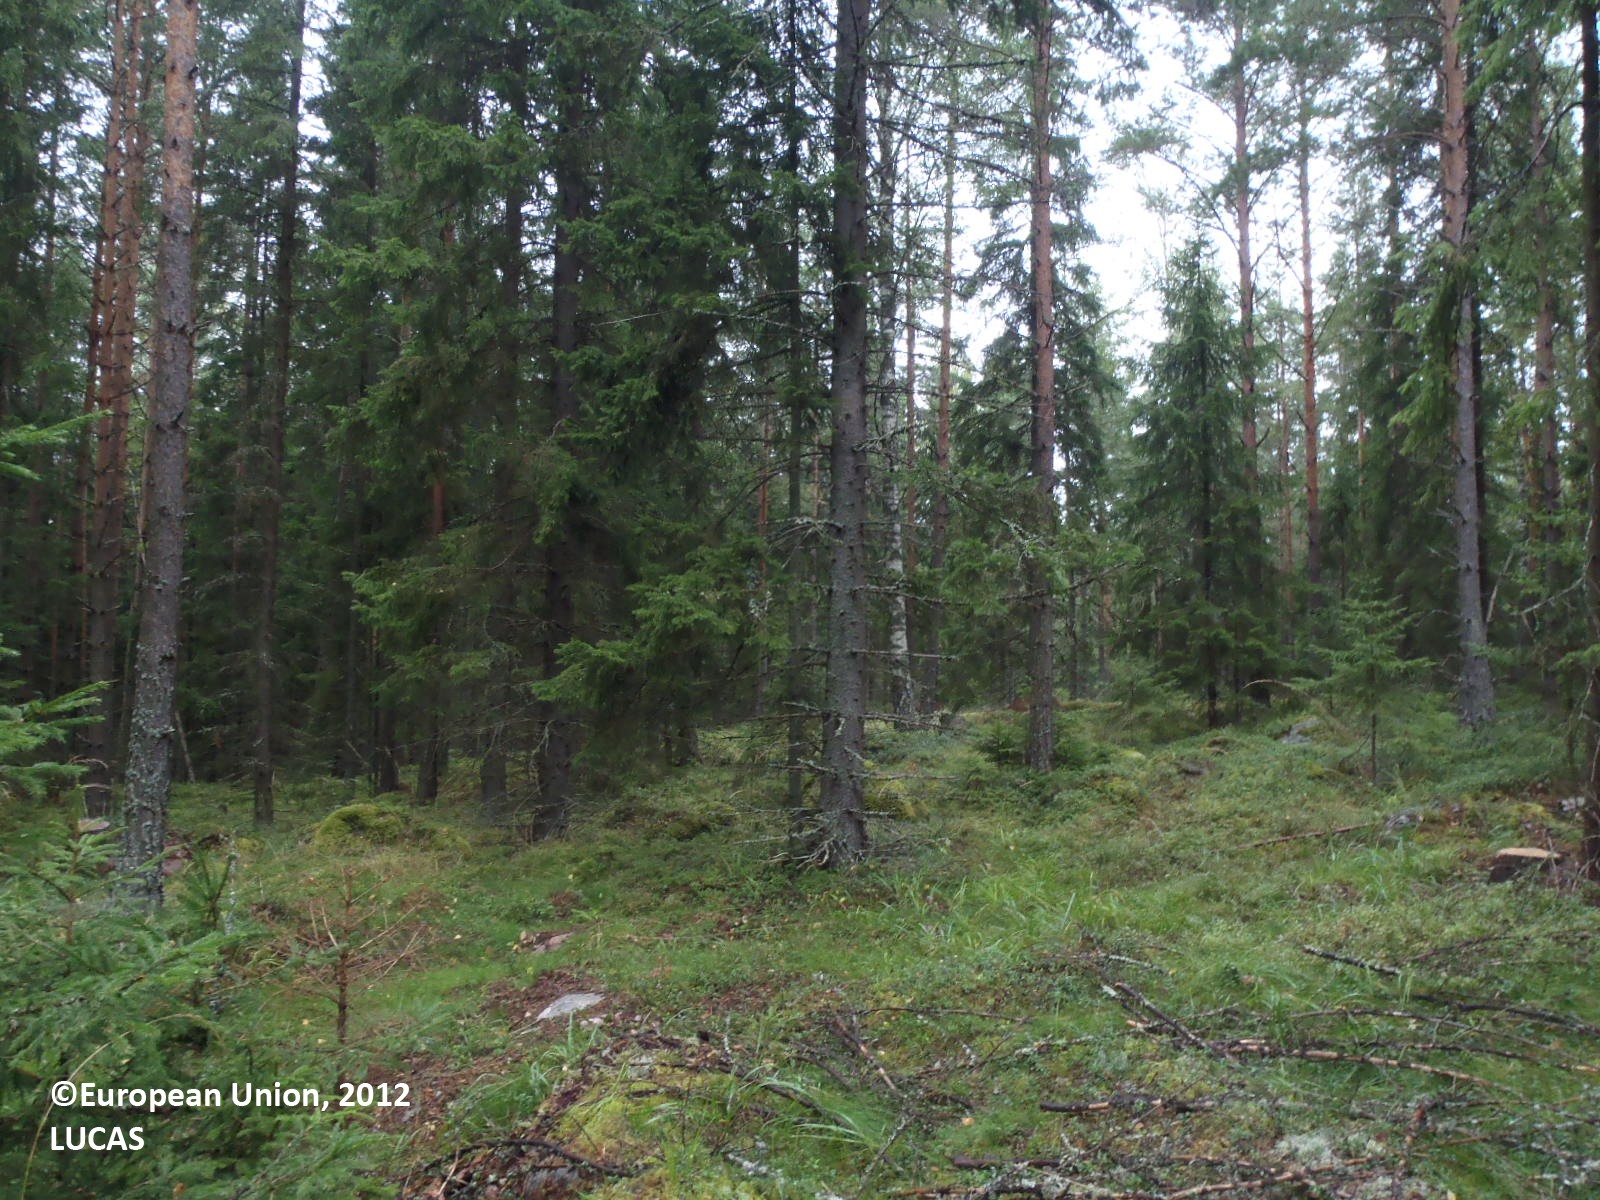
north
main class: Woodland
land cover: Pine dominated coniferous woodland
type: boreal forest
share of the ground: 50 - 75 %
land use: Forestry
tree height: > 5 m
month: September
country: FI
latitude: 60.8531
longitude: 22.8283
